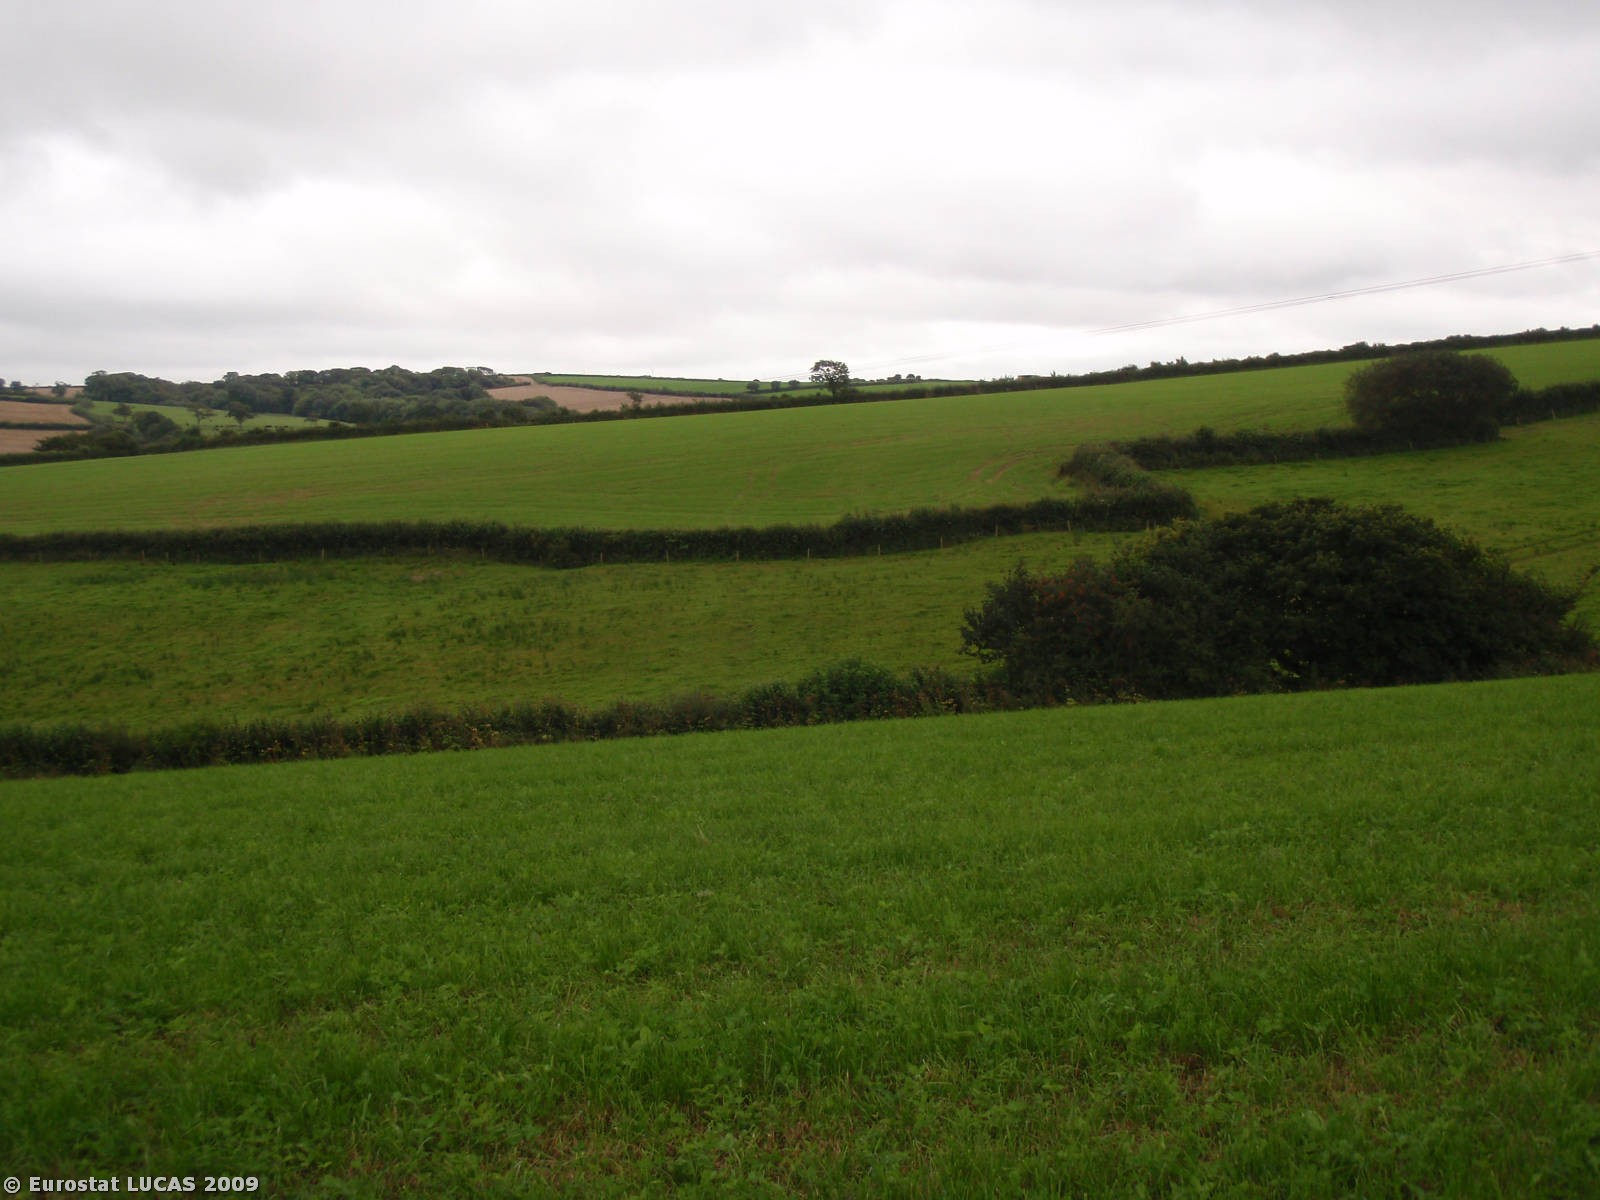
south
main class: Cropland
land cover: Clovers
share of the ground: 50 - 75 %
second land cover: Temporary grasslands
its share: 25 - 50 %
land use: Agriculture (excluding fallow land and kitchen gardens)
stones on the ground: < 10 %
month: July
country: GB
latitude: 50.7683
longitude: -4.3514
